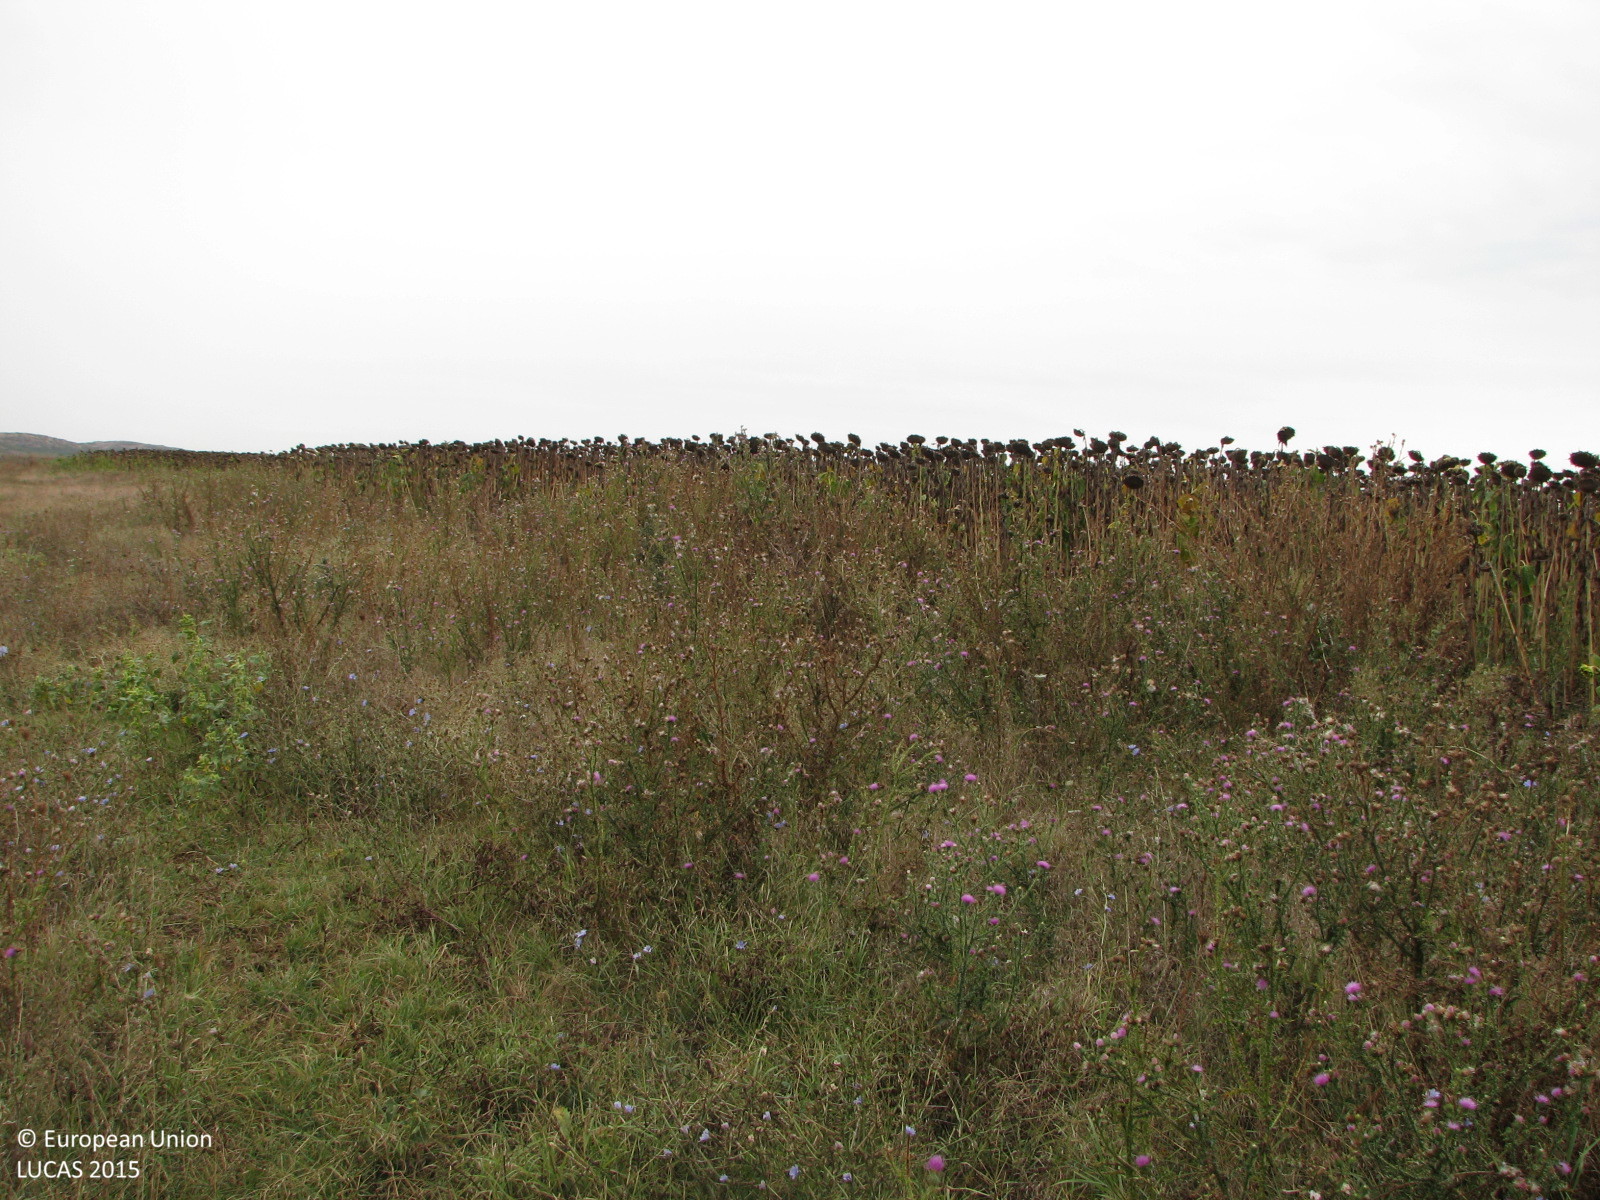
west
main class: Grassland
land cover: Grassland without tree/shrub cover
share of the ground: > 75 %
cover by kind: herbaceous plants 100 %
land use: Agriculture (excluding fallow land and kitchen gardens)
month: September
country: BG
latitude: 42.5296
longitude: 26.5661
